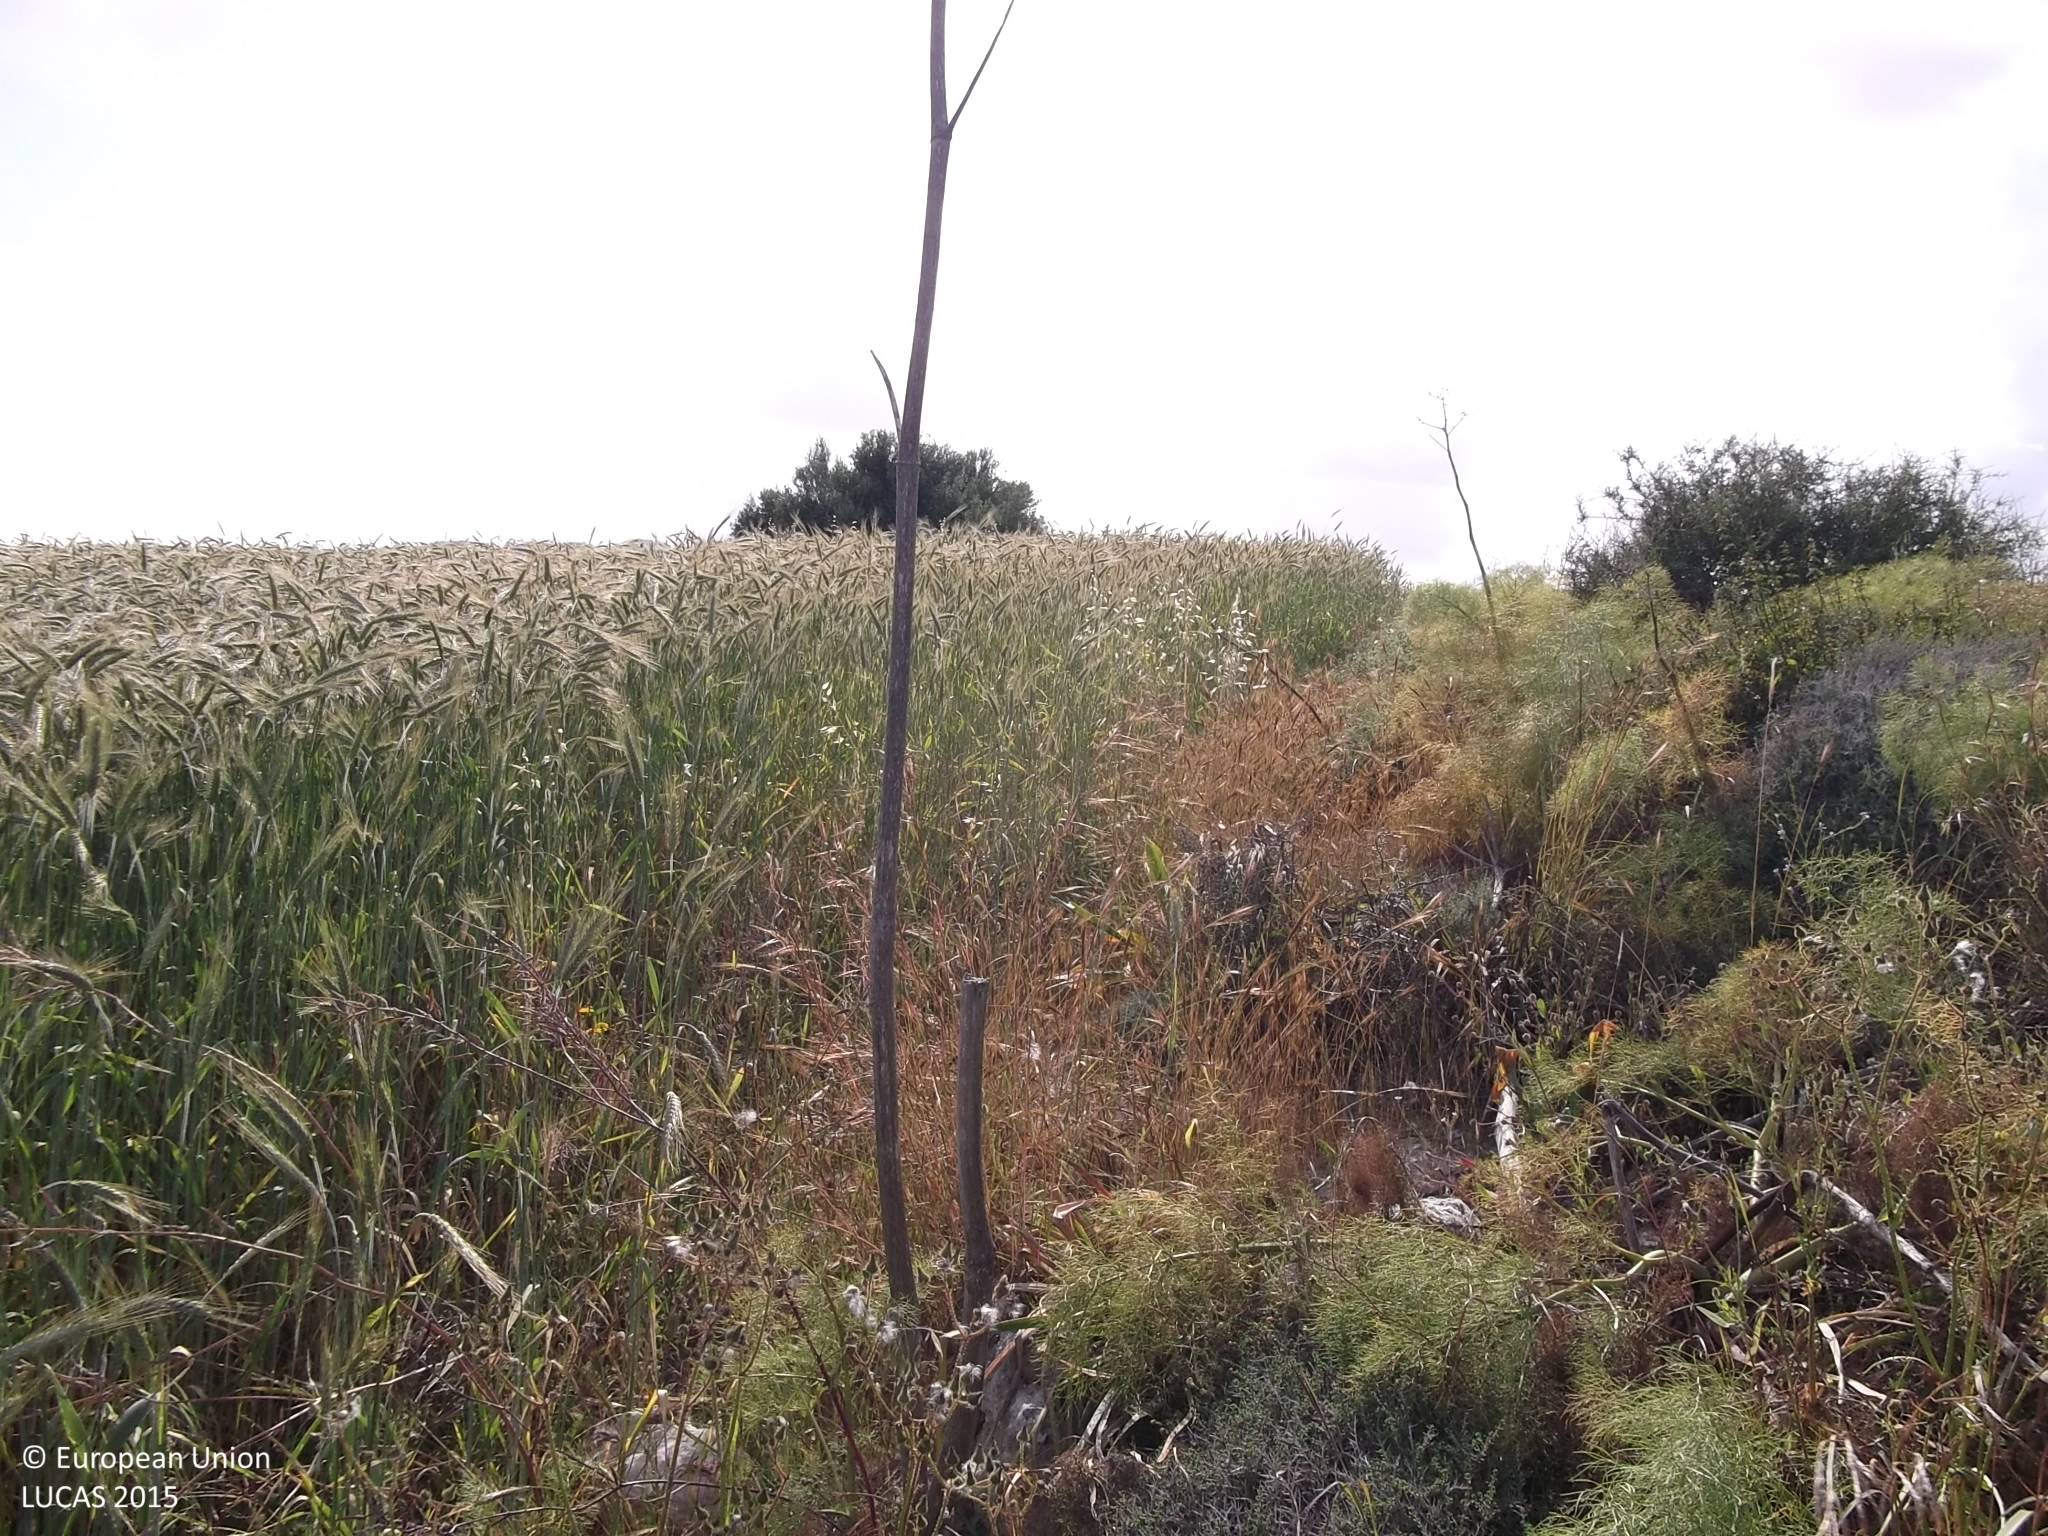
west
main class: Shrubland
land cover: Shrubland without tree cover
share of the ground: 50 - 75 %
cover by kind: shrubs 70 %, herbaceous plants 20 %, unconsolidated bare surface 10 %
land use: Semi-natural and natural areas not in use
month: April
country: CY
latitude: 34.7952
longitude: 33.4313
